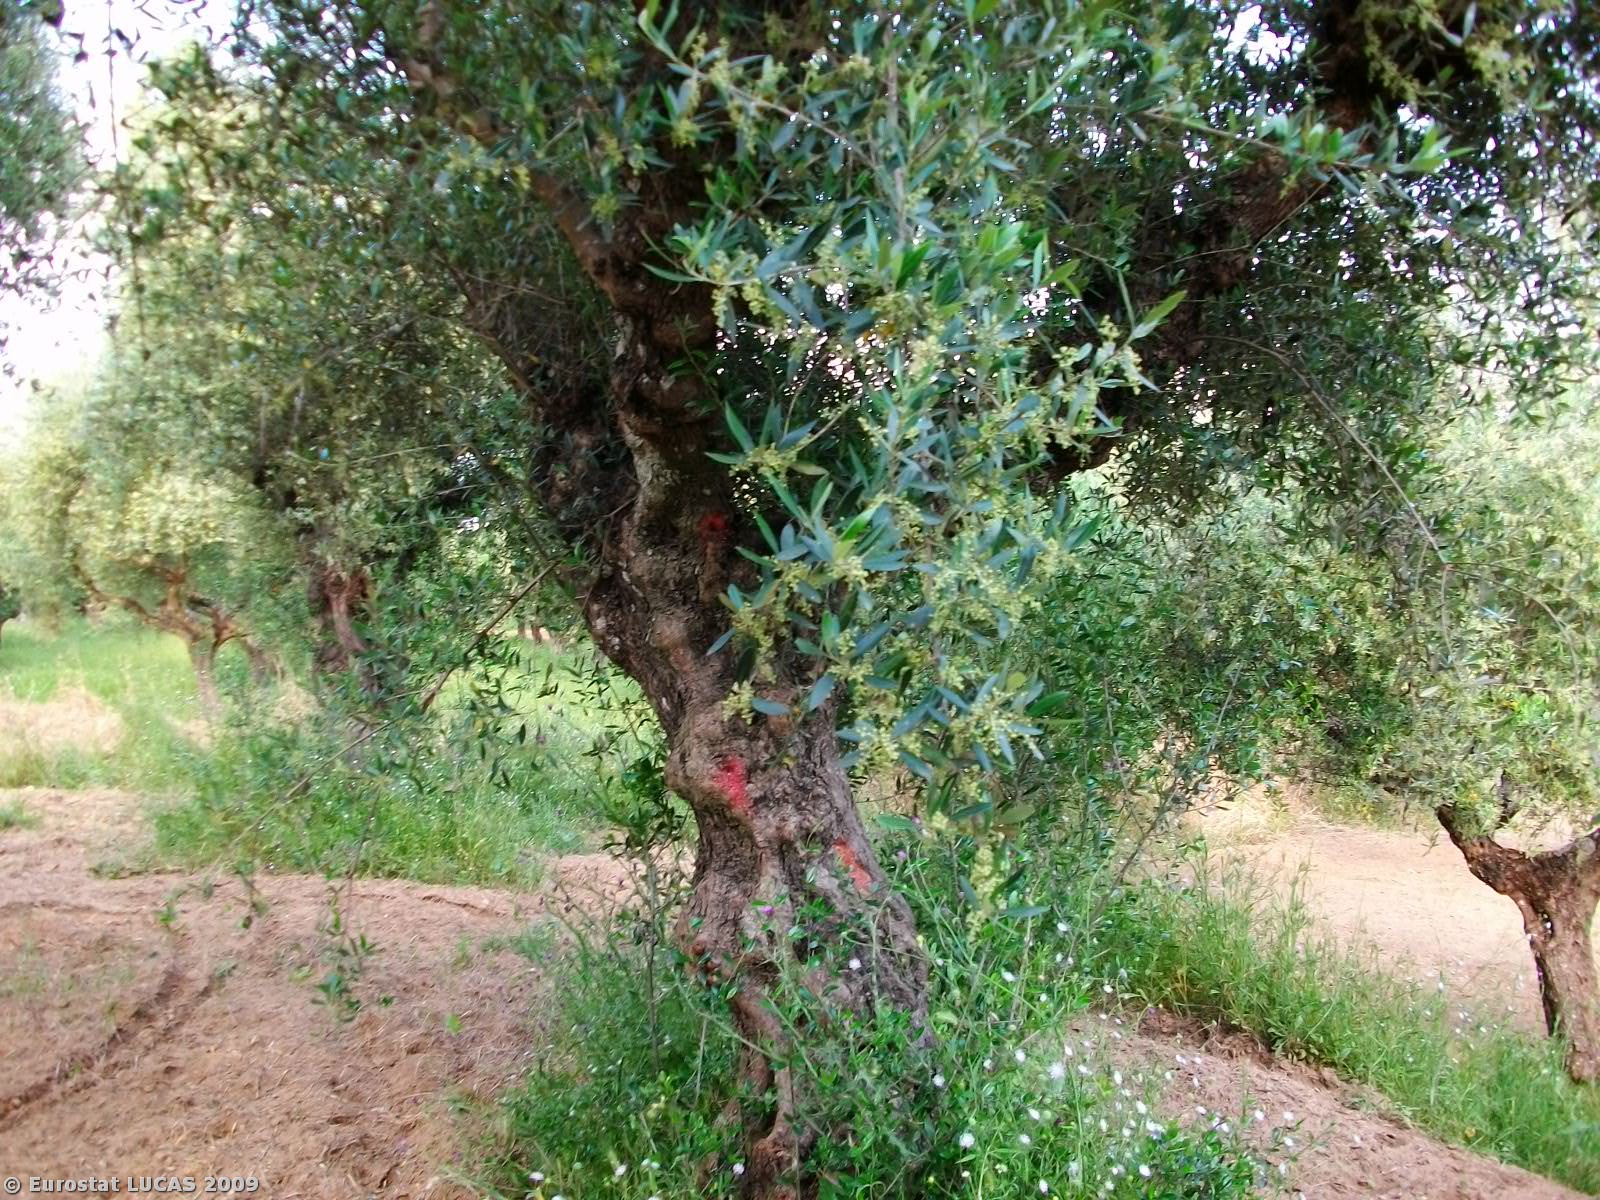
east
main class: Cropland
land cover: Olive groves
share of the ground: > 75 %
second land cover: Bare land
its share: 50 - 75 %
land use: Agriculture (excluding fallow land and kitchen gardens)
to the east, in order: Olive groves; Bare land; Tracks; Olive groves; Grassland with sparse tree/shrub cover; Tracks; Olive groves; Grassland with sparse tree/shrub cover
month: May
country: GR
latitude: 37.1121
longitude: 22.0066
